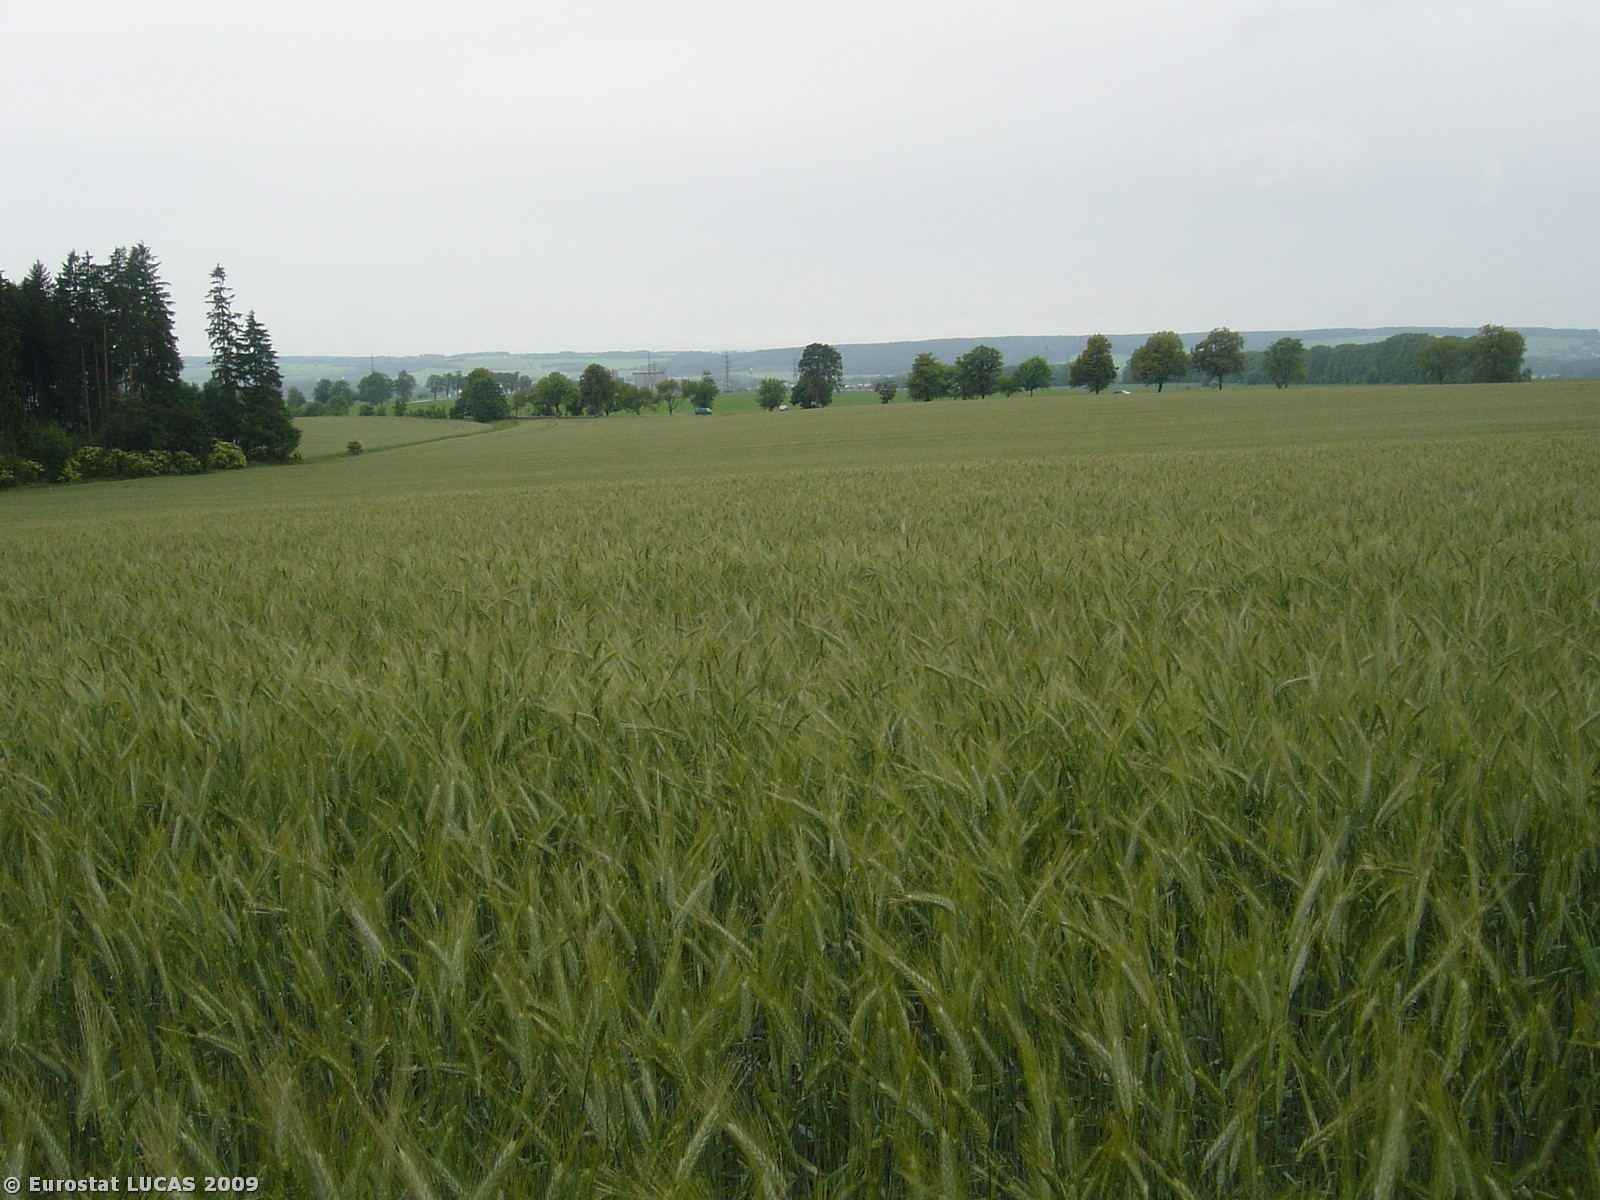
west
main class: Cropland
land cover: Triticale
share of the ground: > 75 %
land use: Agriculture (excluding fallow land and kitchen gardens)
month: June
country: CZ
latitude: 49.7631
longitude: 16.5185
